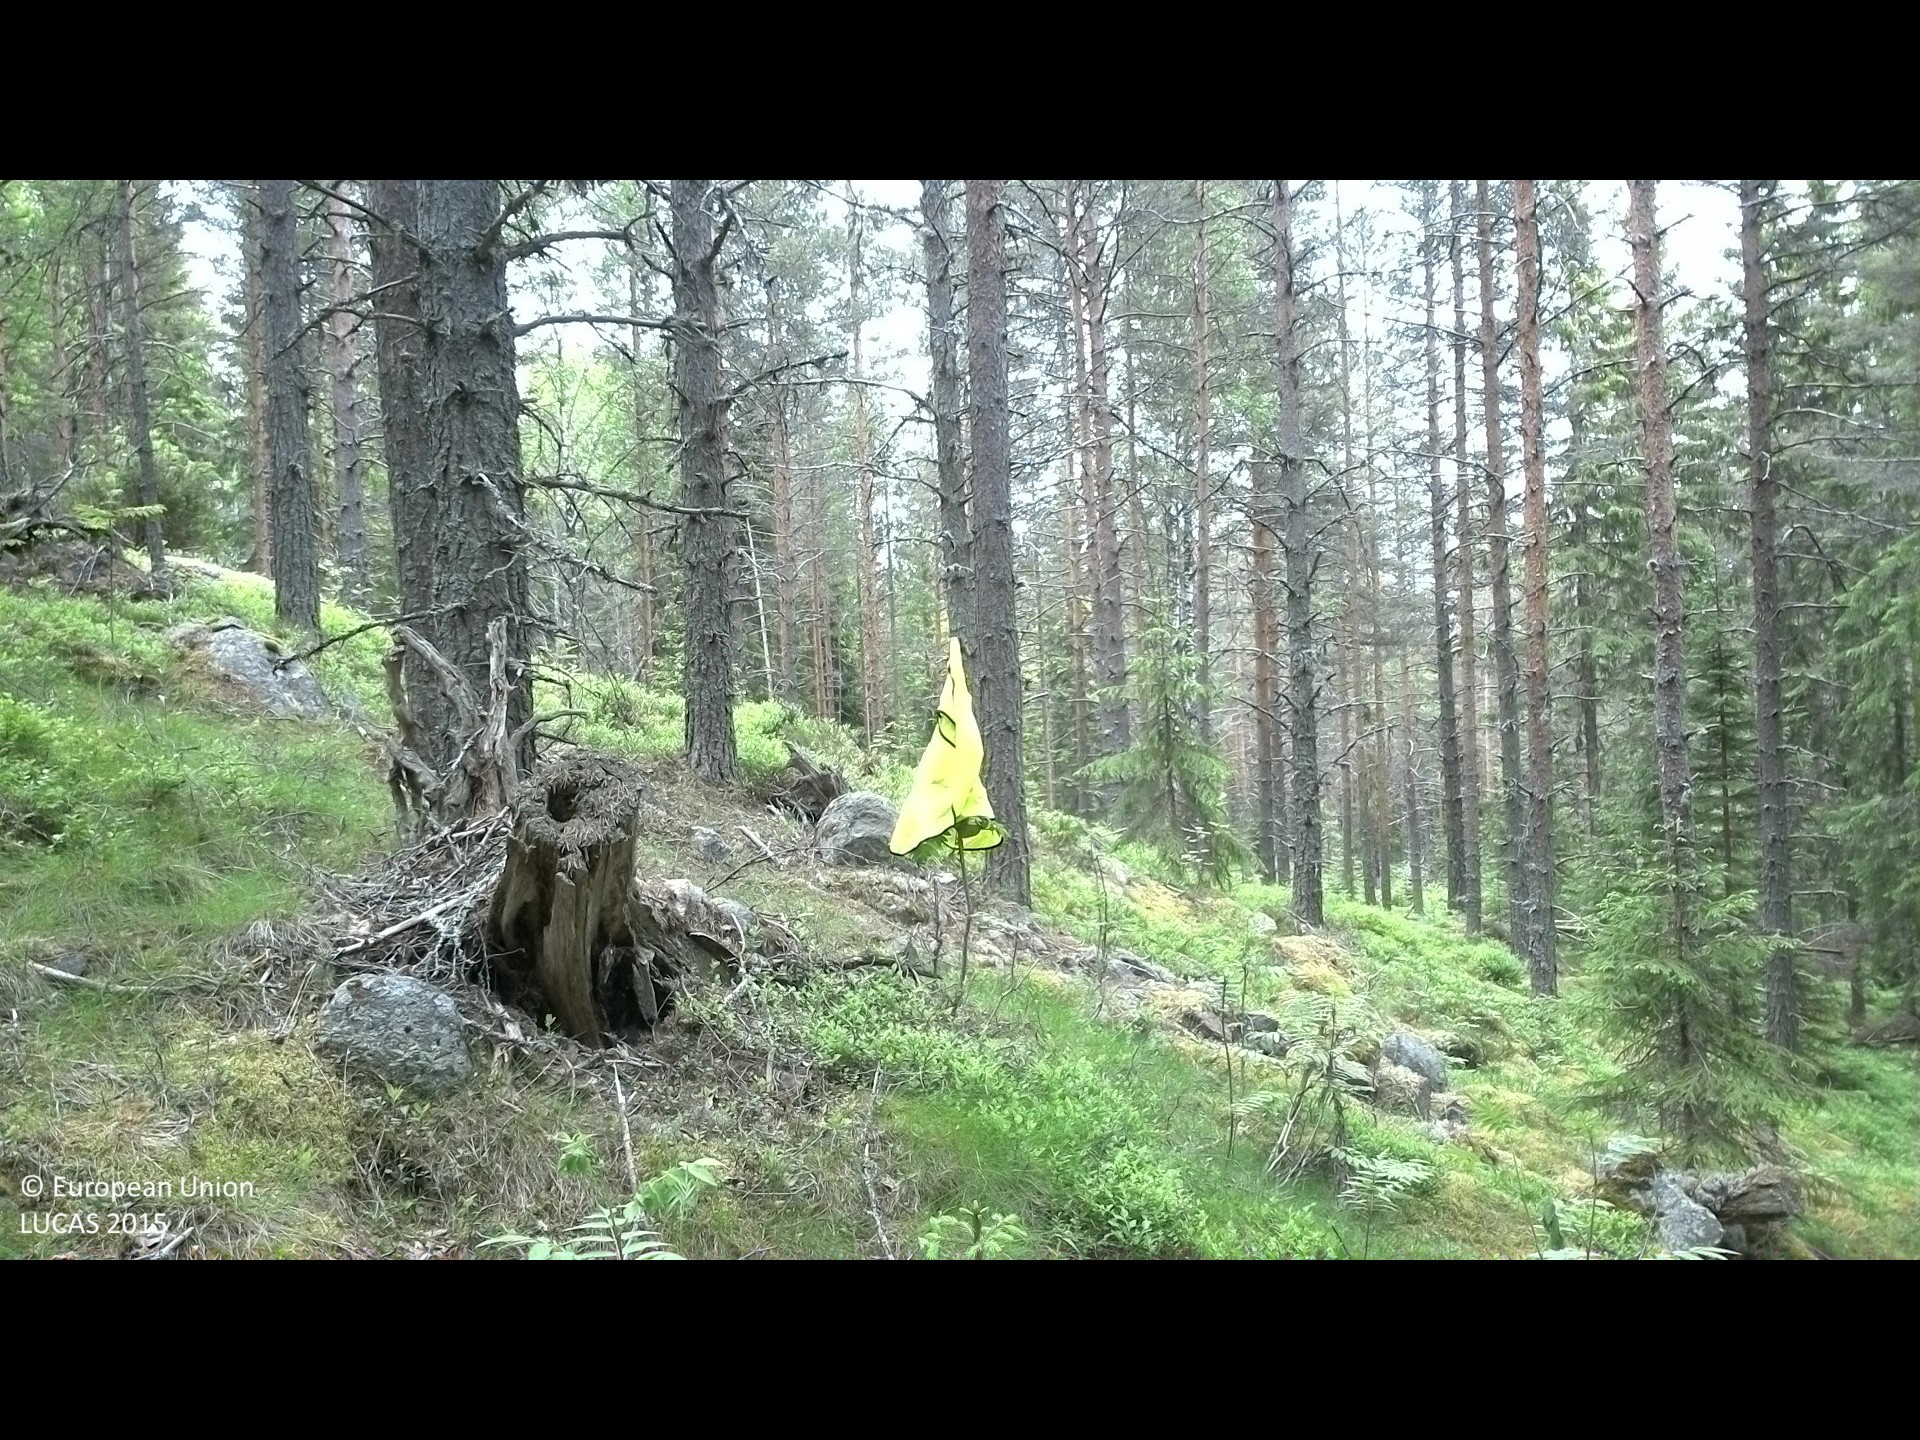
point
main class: Woodland
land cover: Pine dominated coniferous woodland
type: boreal forest
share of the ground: 50 - 75 %
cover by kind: coniferous forest trees 50 %, shrubs 30 %, lichens and mosses 20 %
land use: Forestry
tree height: > 5 m
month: June
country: SE
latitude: 62.0068
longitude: 16.3795
